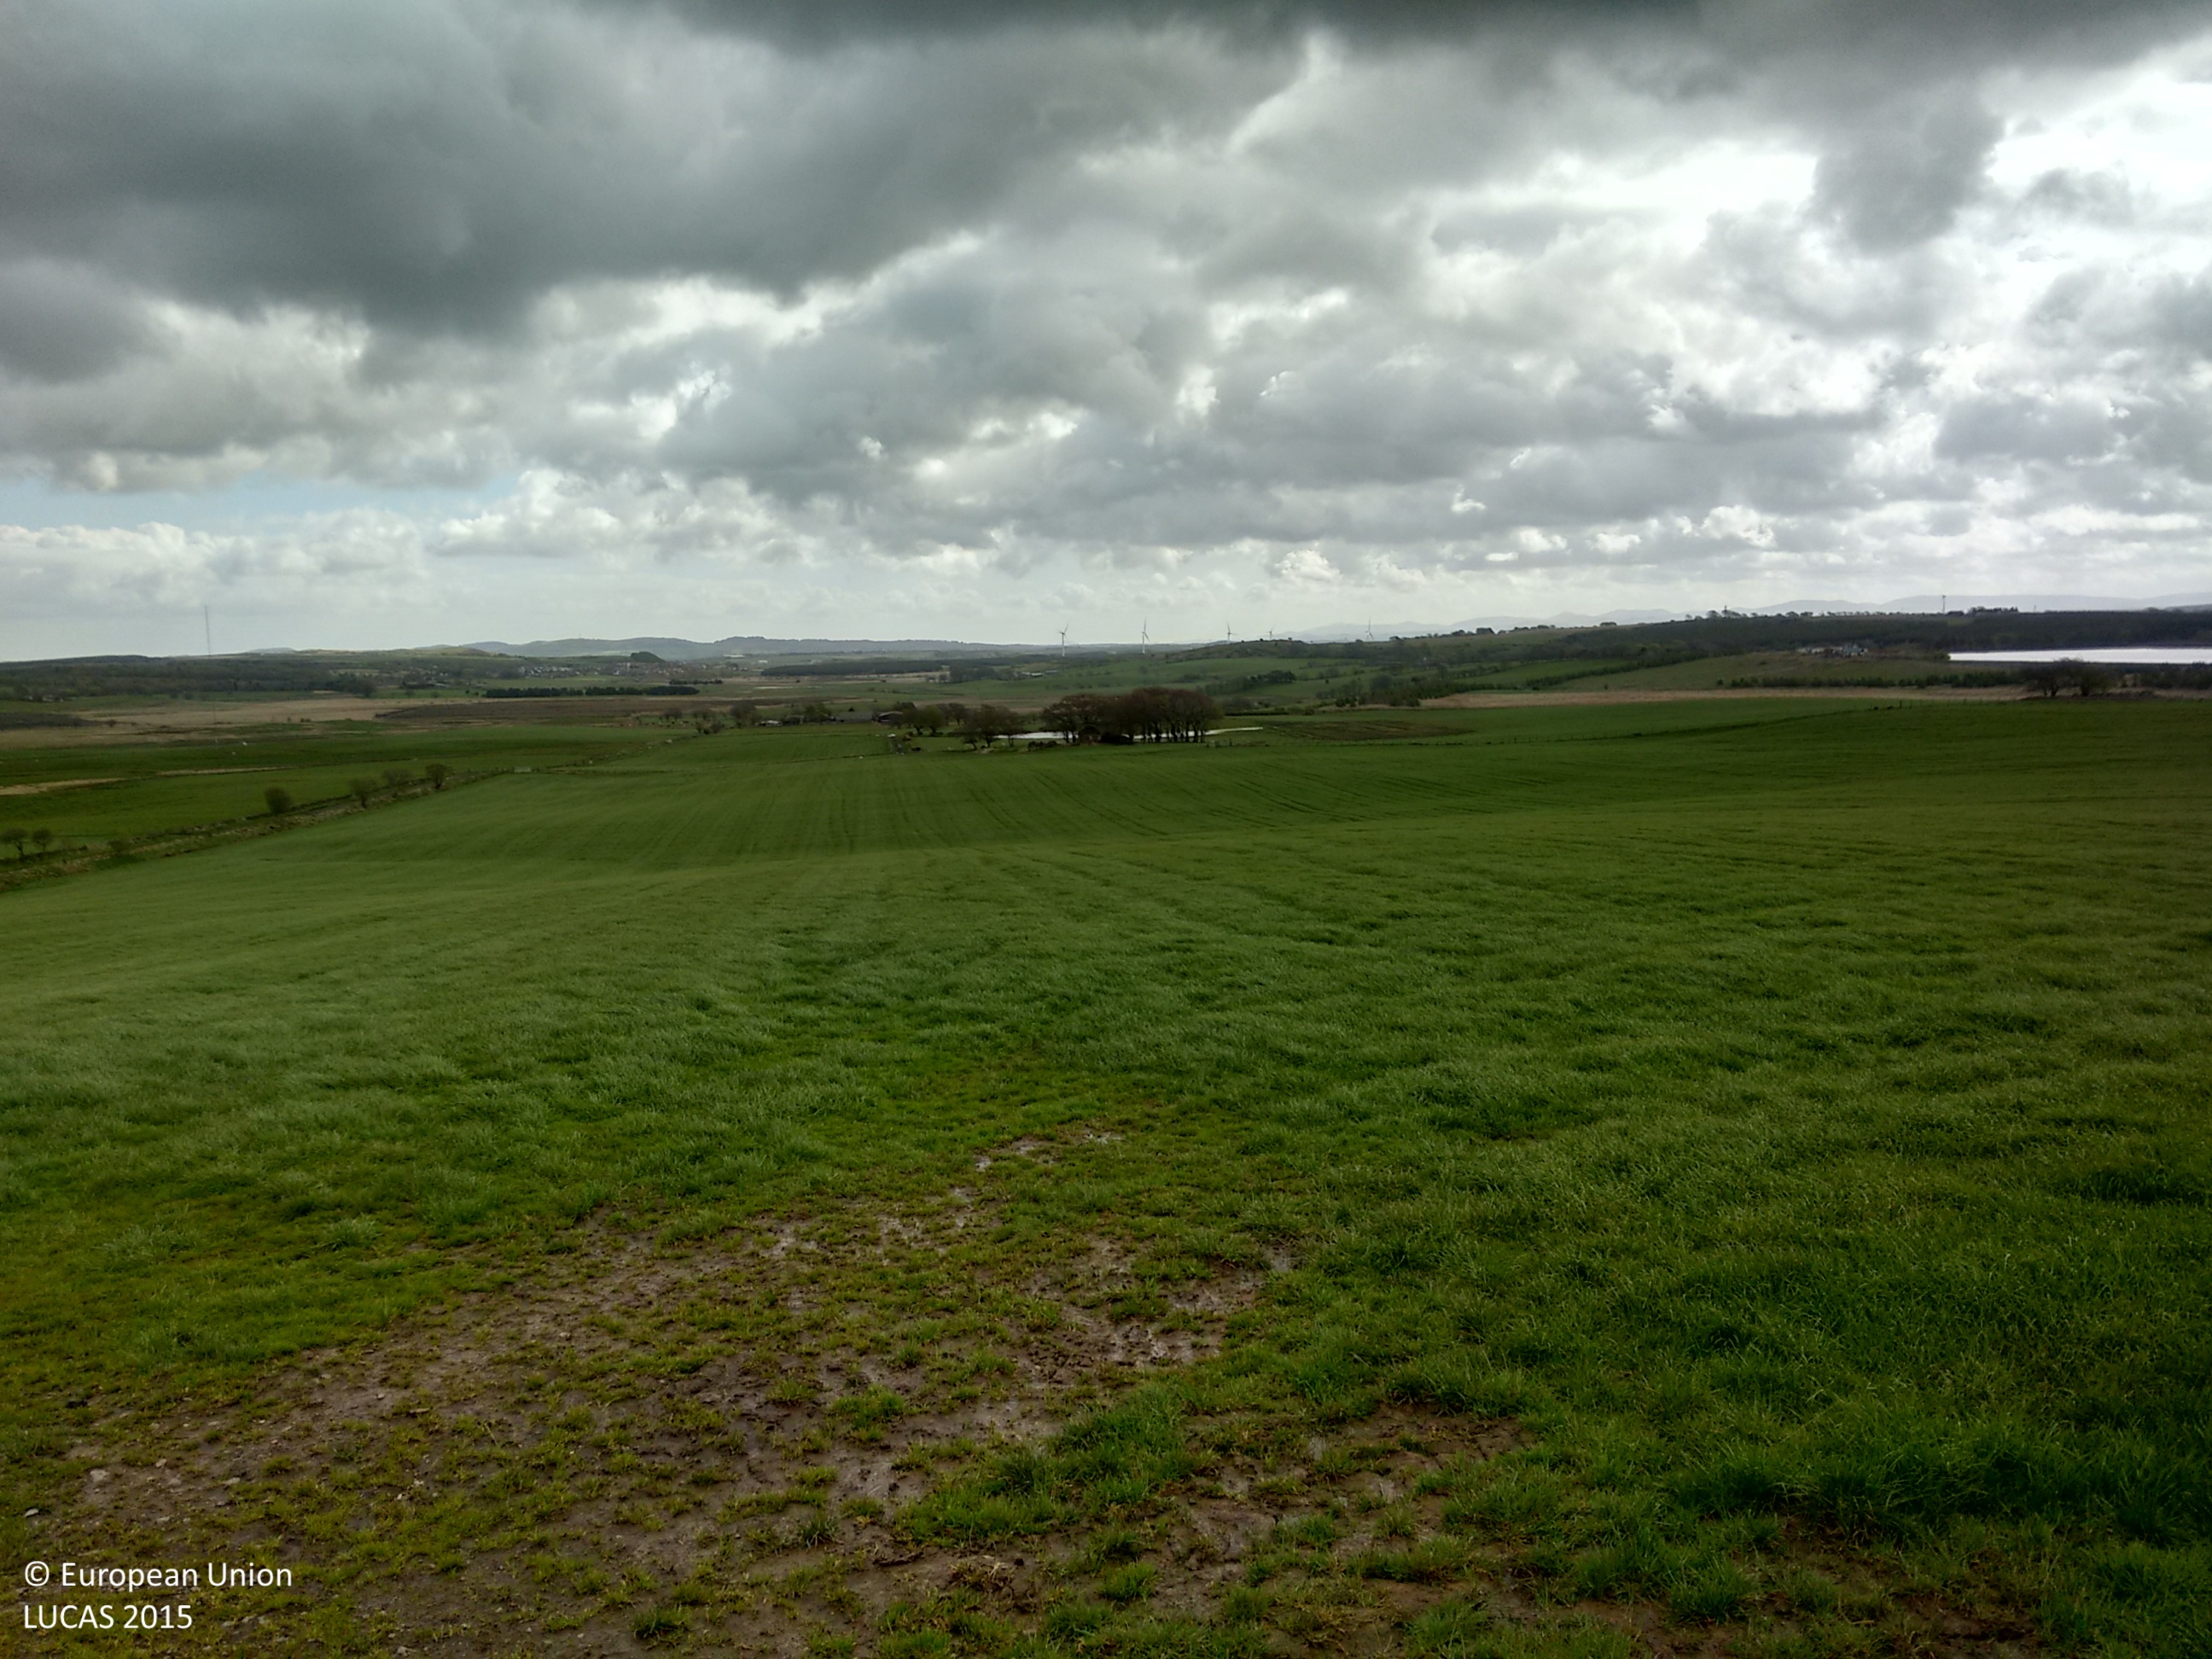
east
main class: Grassland
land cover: Grassland without tree/shrub cover
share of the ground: > 75 %
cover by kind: herbaceous plants 100 %
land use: Agriculture (excluding fallow land and kitchen gardens)
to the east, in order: Grassland without tree/shrub cover
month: May
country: GB
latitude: 55.8743
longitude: -3.8132
